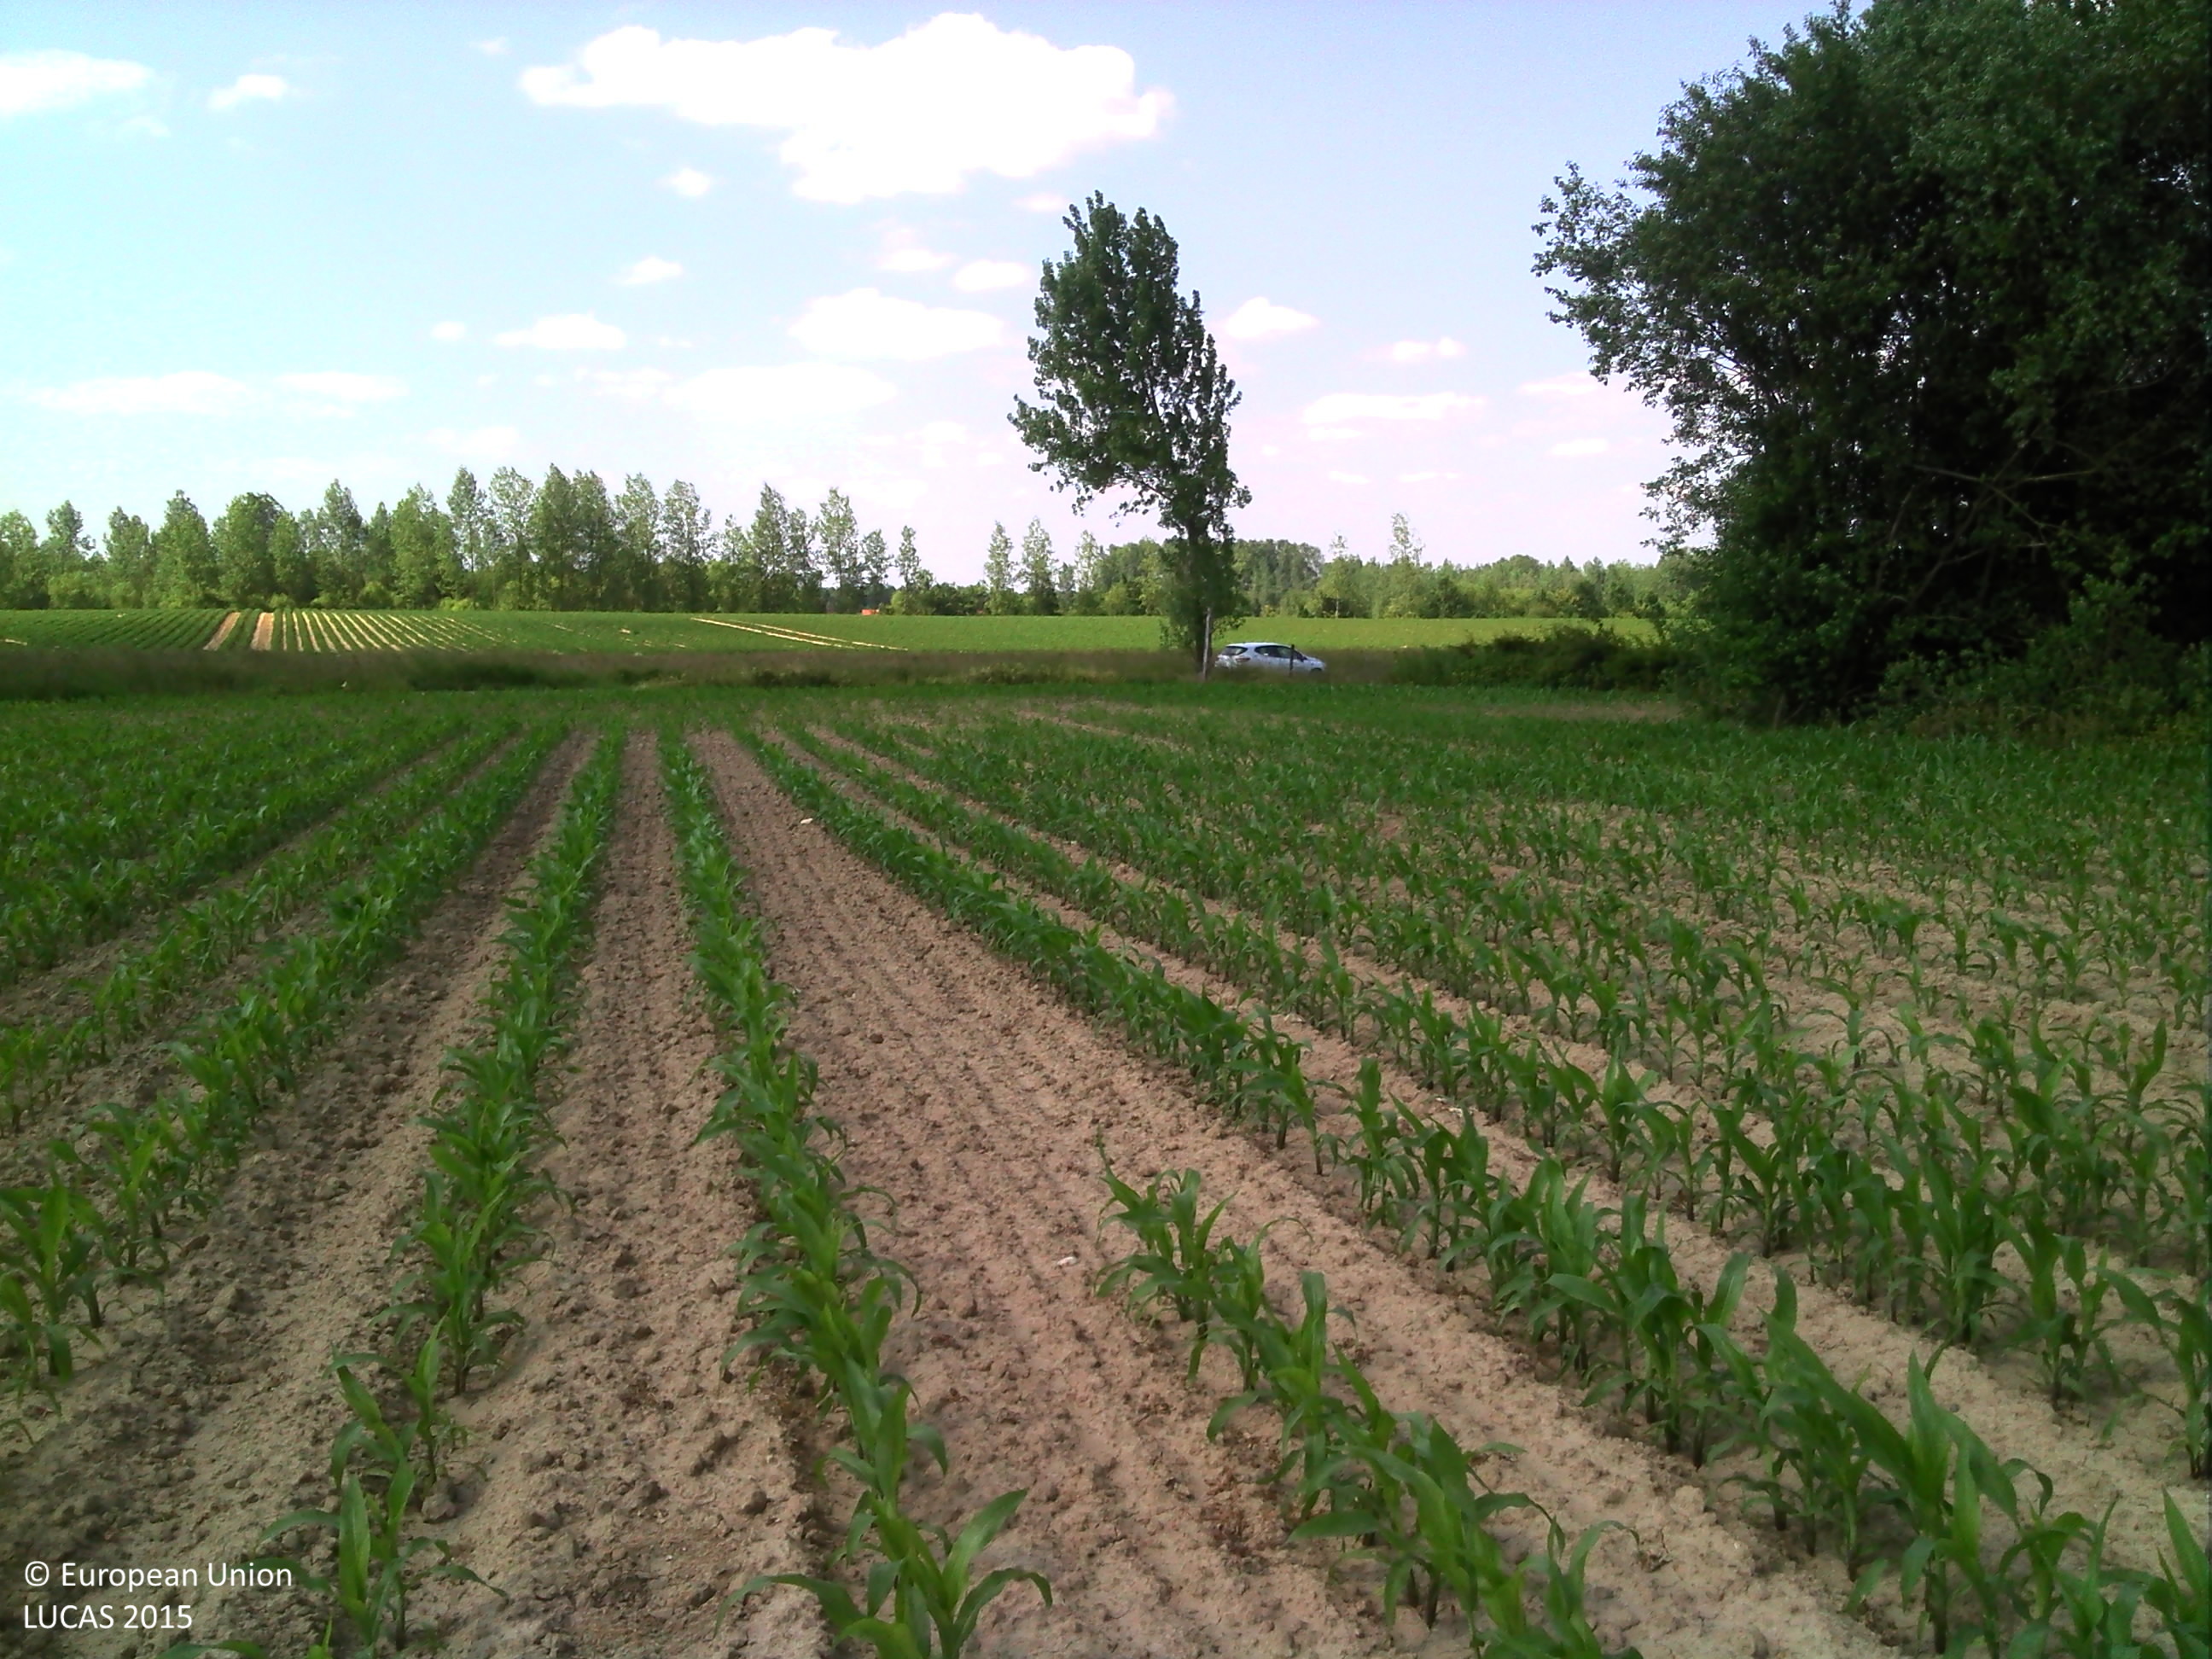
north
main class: Cropland
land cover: Maize
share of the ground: 25 - 50 %
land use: Agriculture (excluding fallow land and kitchen gardens)
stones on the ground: < 10 %
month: June
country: BE
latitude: 50.7597
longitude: 5.4474
